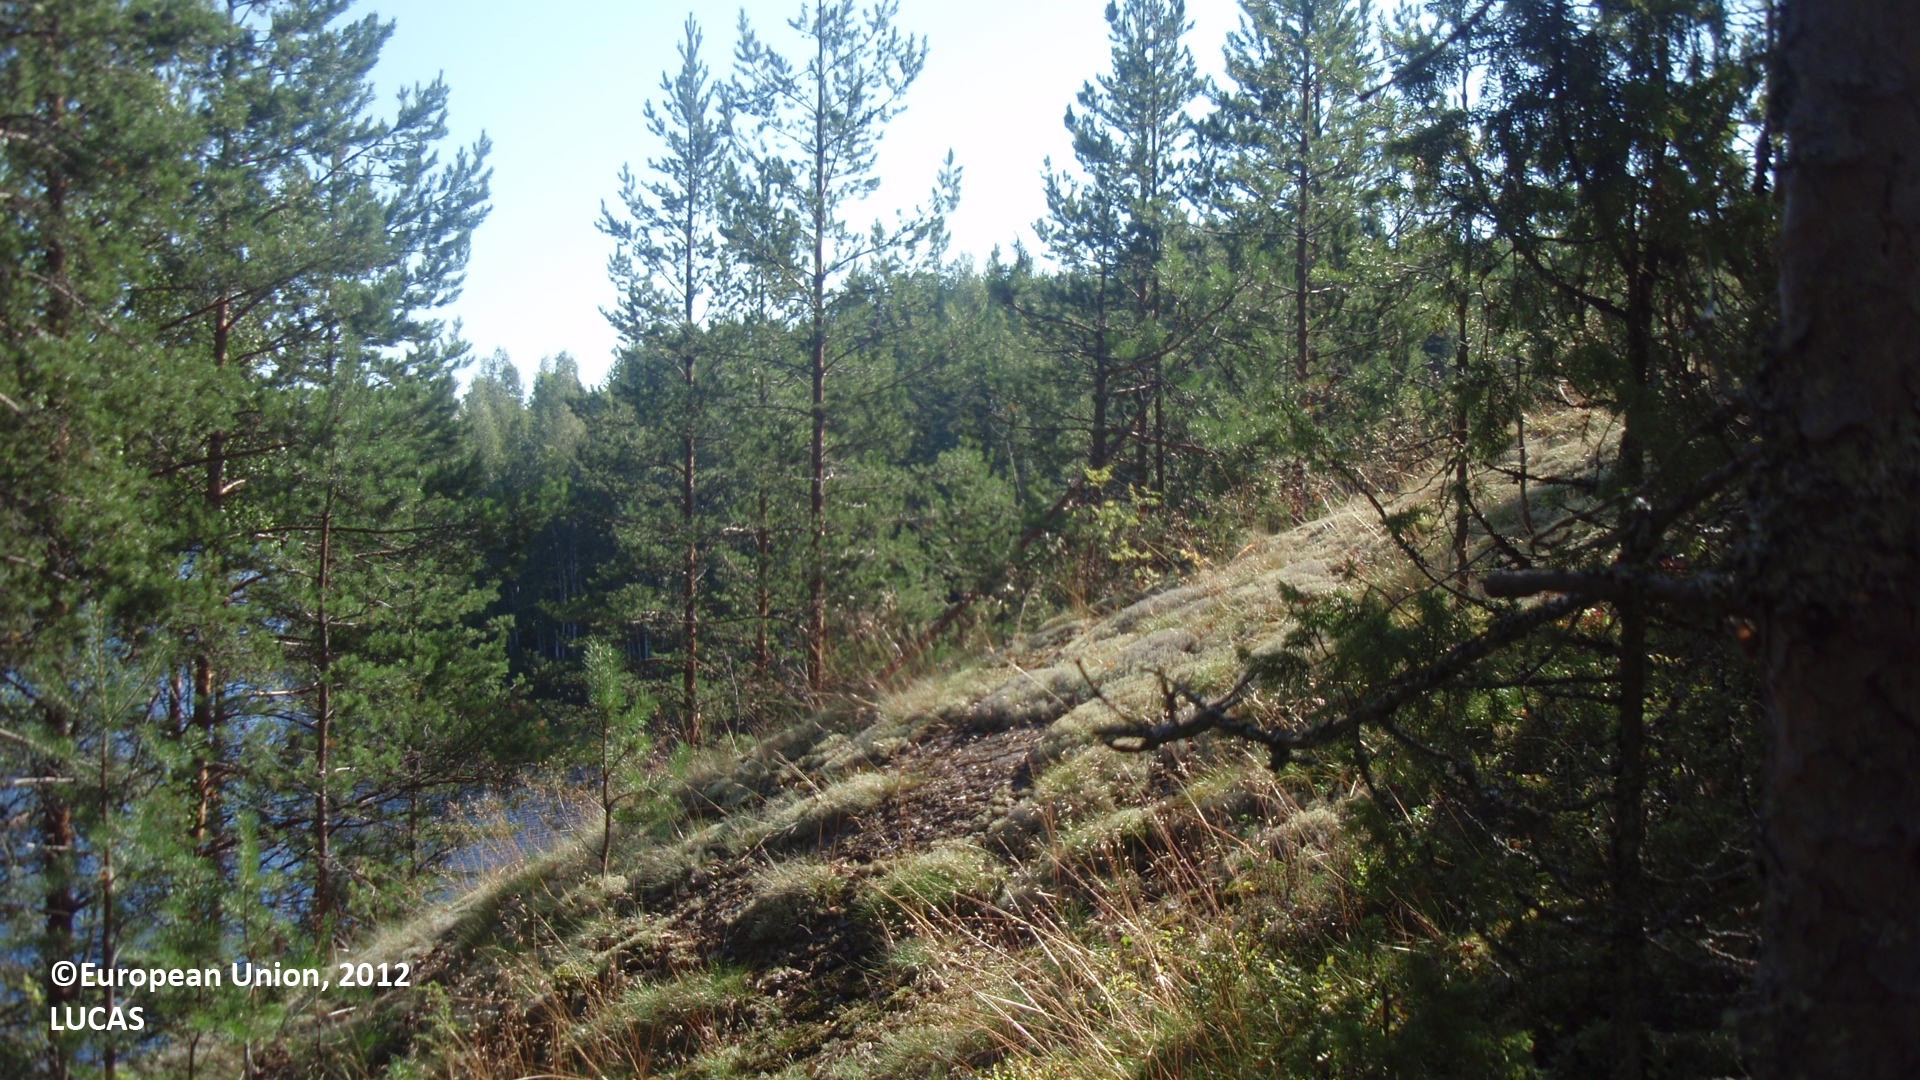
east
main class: Woodland
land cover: Pine dominated coniferous woodland
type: boreal forest
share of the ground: 50 - 75 %
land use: Forestry
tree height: > 5 m
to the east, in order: Pine dominated coniferous woodland; Lichens and moss; Inland water bodies; Broadleaved woodland; Pine dominated mixed woodland
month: August
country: FI
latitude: 61.4358
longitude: 27.8699
